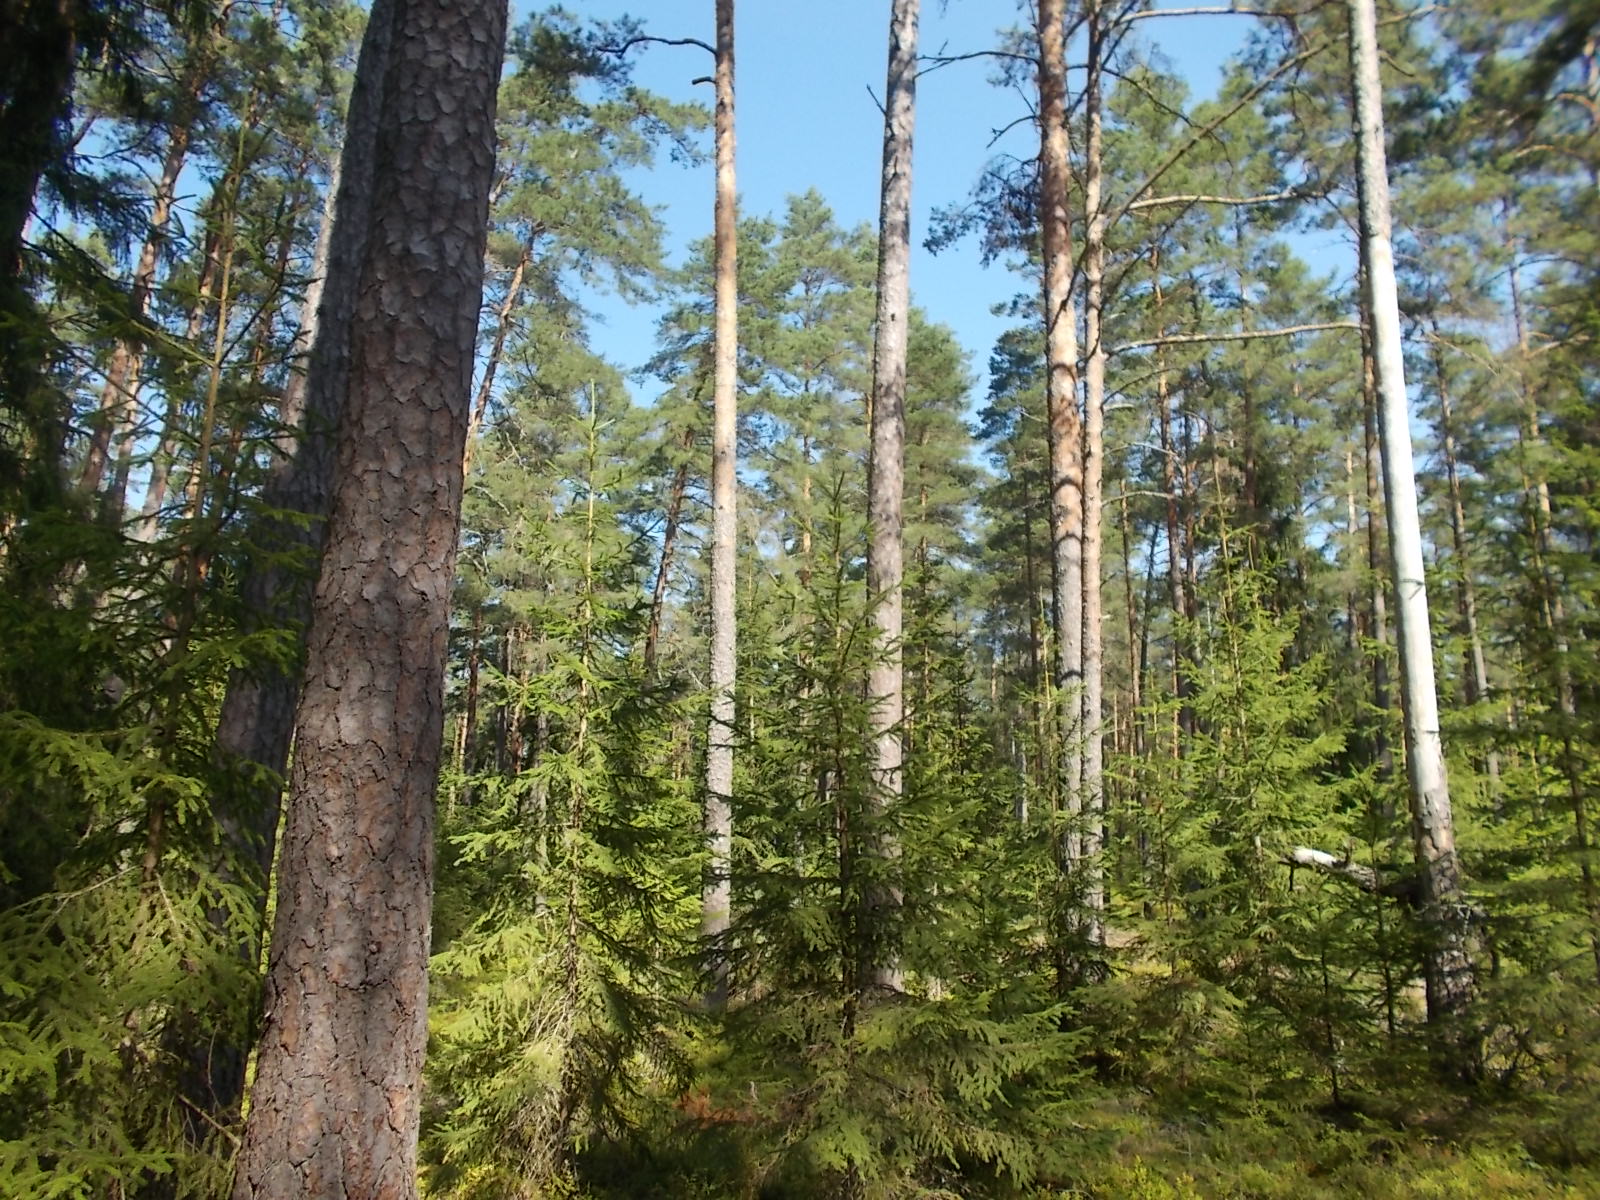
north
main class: Woodland
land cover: Other coniferous woodland
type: hemiboreal forest and nemoral coniferous forest and mixed broadleaved-coniferous forest
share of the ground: 50 - 75 %
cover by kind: coniferous forest trees 70 %, shrubs 15 %, lichens and mosses 10 %, herbaceous plants 5 %
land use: Forestry
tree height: > 5 m
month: August
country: LV
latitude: 57.0868
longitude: 21.9099
